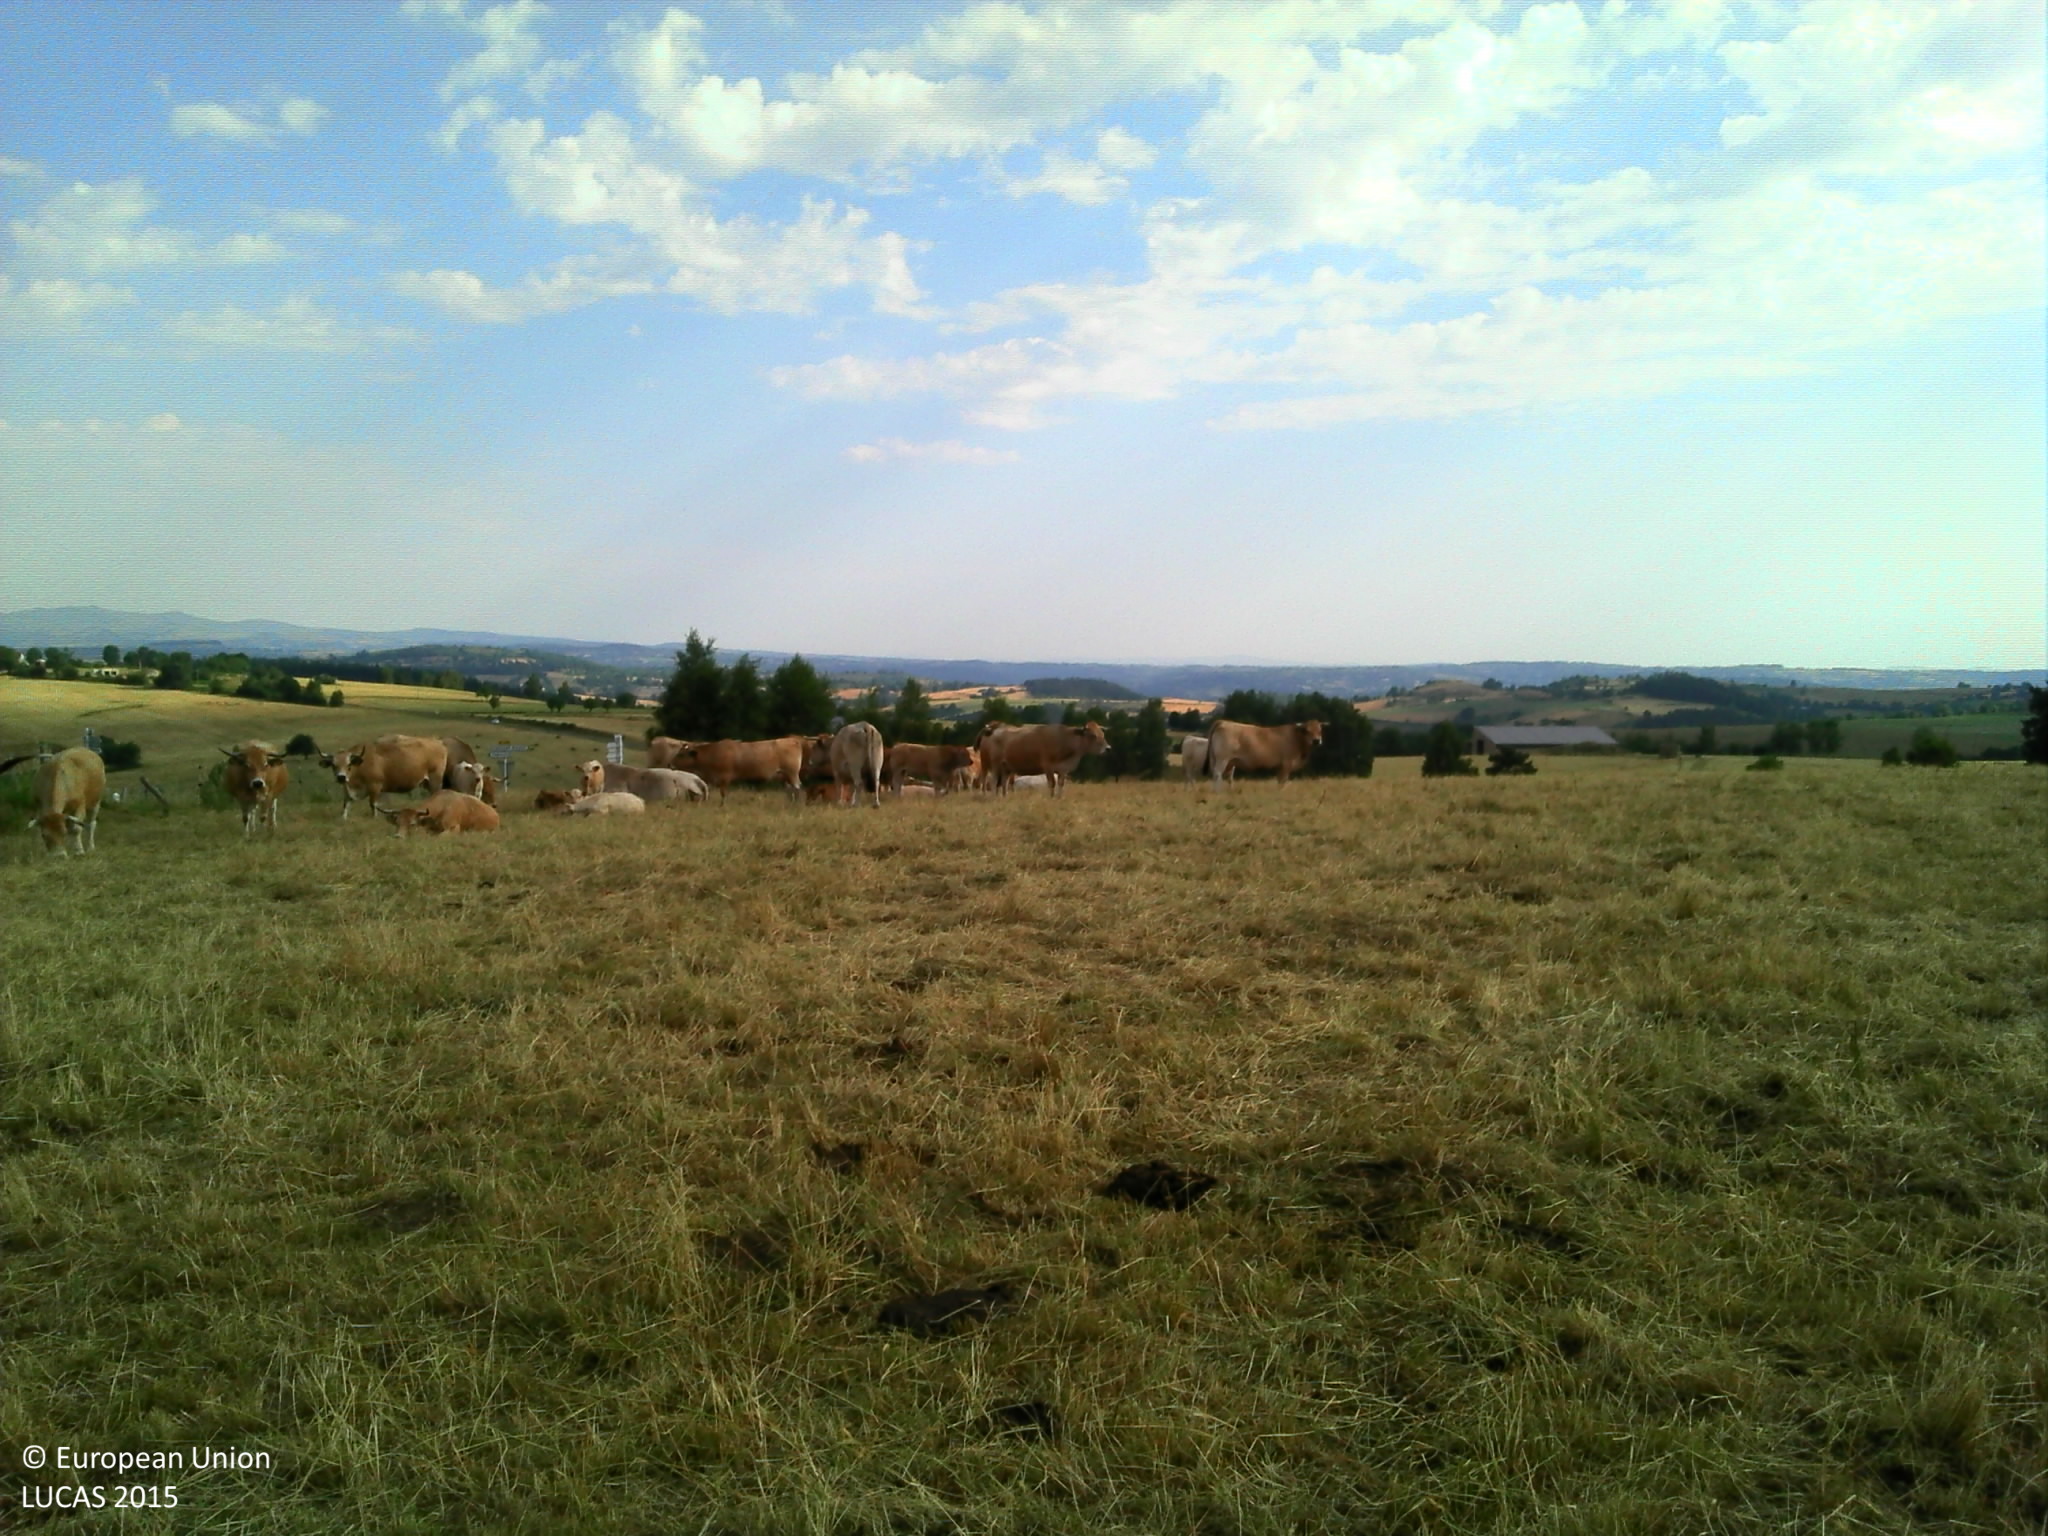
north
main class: Grassland
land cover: Grassland without tree/shrub cover
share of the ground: > 75 %
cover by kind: herbaceous plants 100 %
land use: Agriculture (excluding fallow land and kitchen gardens)
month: July
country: FR
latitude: 44.8170
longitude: 2.9591
